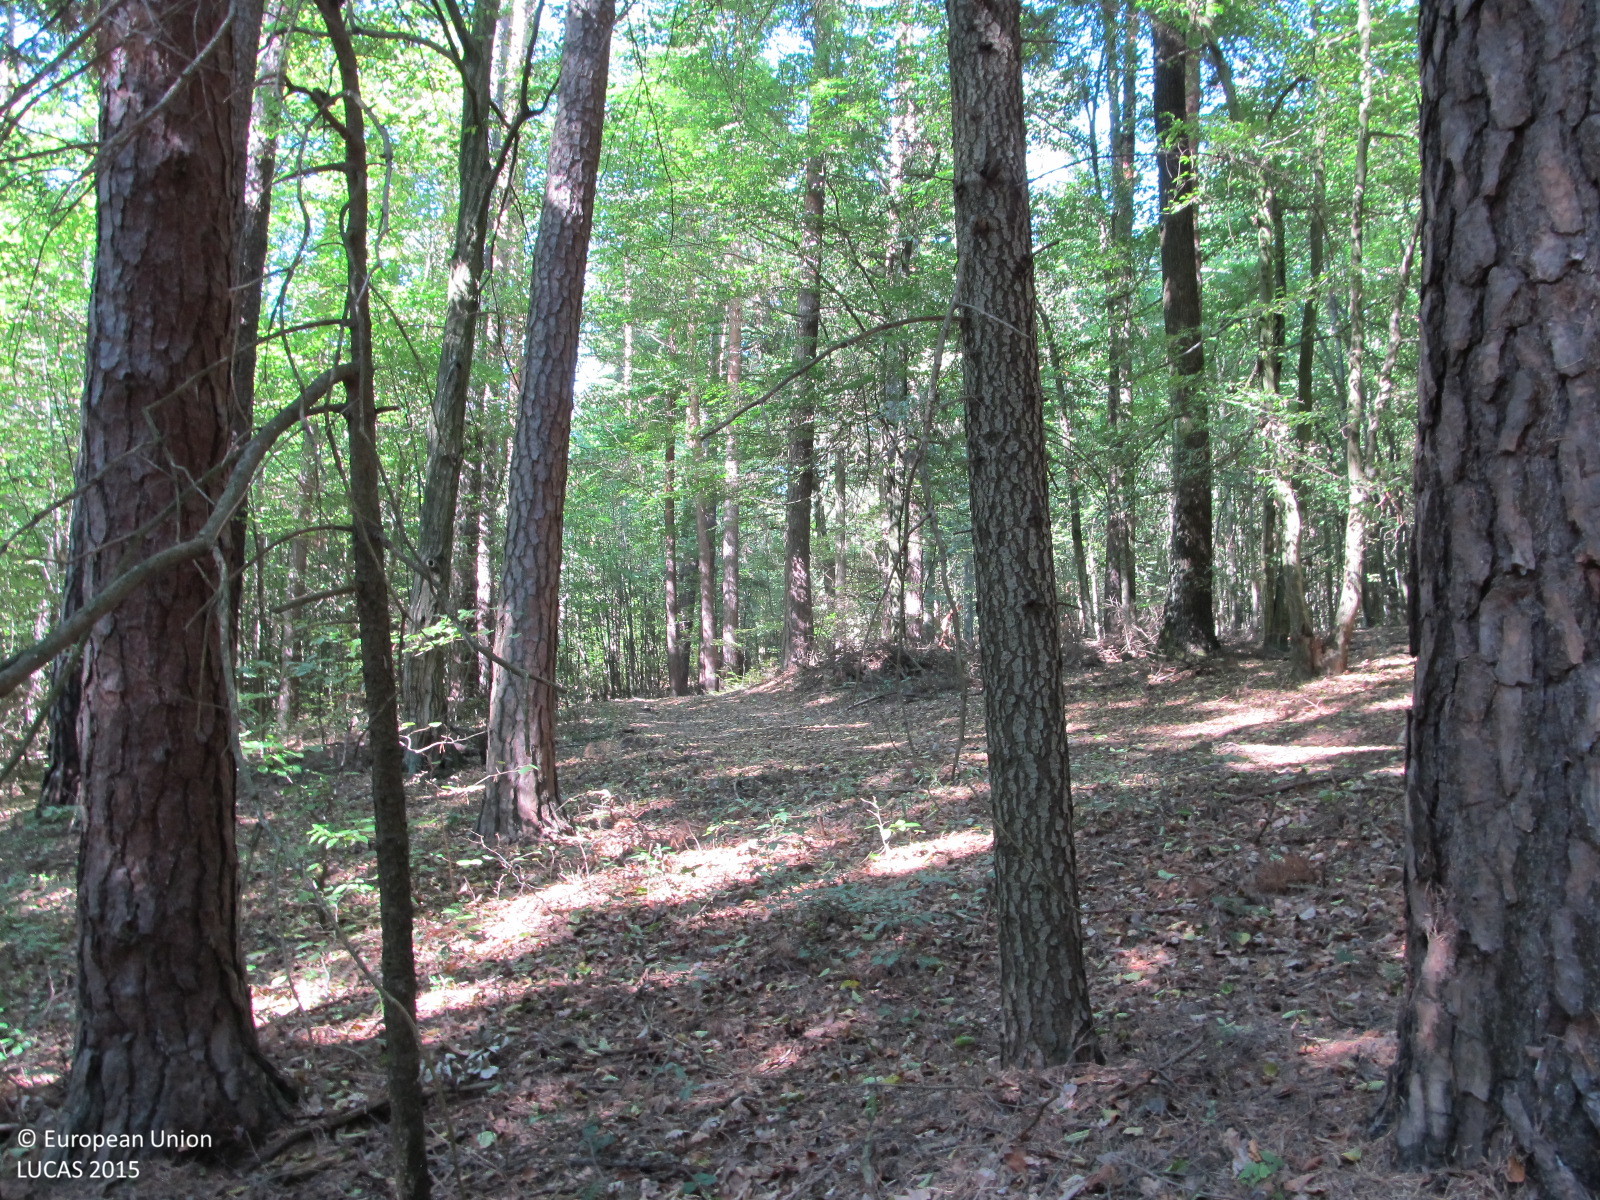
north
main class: Woodland
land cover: Pine dominated coniferous woodland
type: hemiboreal forest and nemoral coniferous forest and mixed broadleaved-coniferous forest
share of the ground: > 75 %
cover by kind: coniferous forest trees 80 %, unconsolidated bare surface 15 %, shrubs 5 %
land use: Forestry
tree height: > 5 m
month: August
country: AT
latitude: 48.6274
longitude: 15.4979
